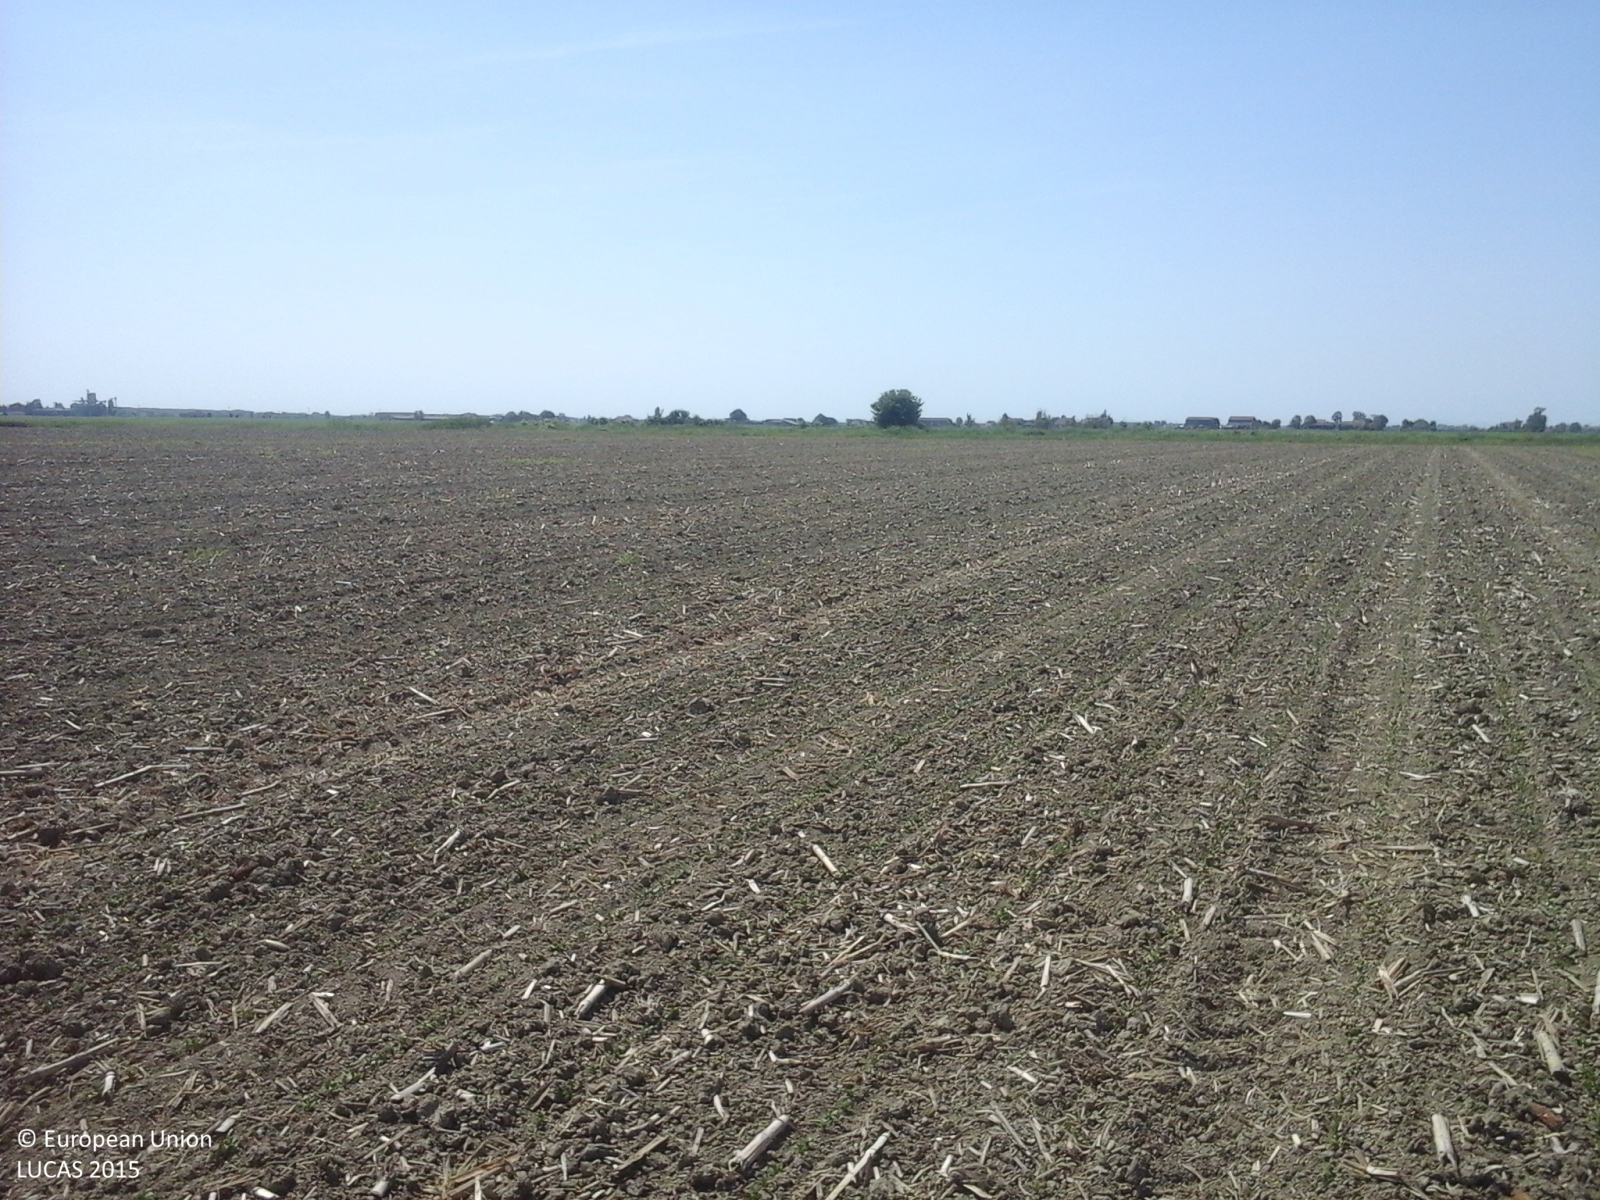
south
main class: Cropland
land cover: Soya
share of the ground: < 10 %
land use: Agriculture (excluding fallow land and kitchen gardens)
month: May
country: IT
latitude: 44.9858
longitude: 11.7089
